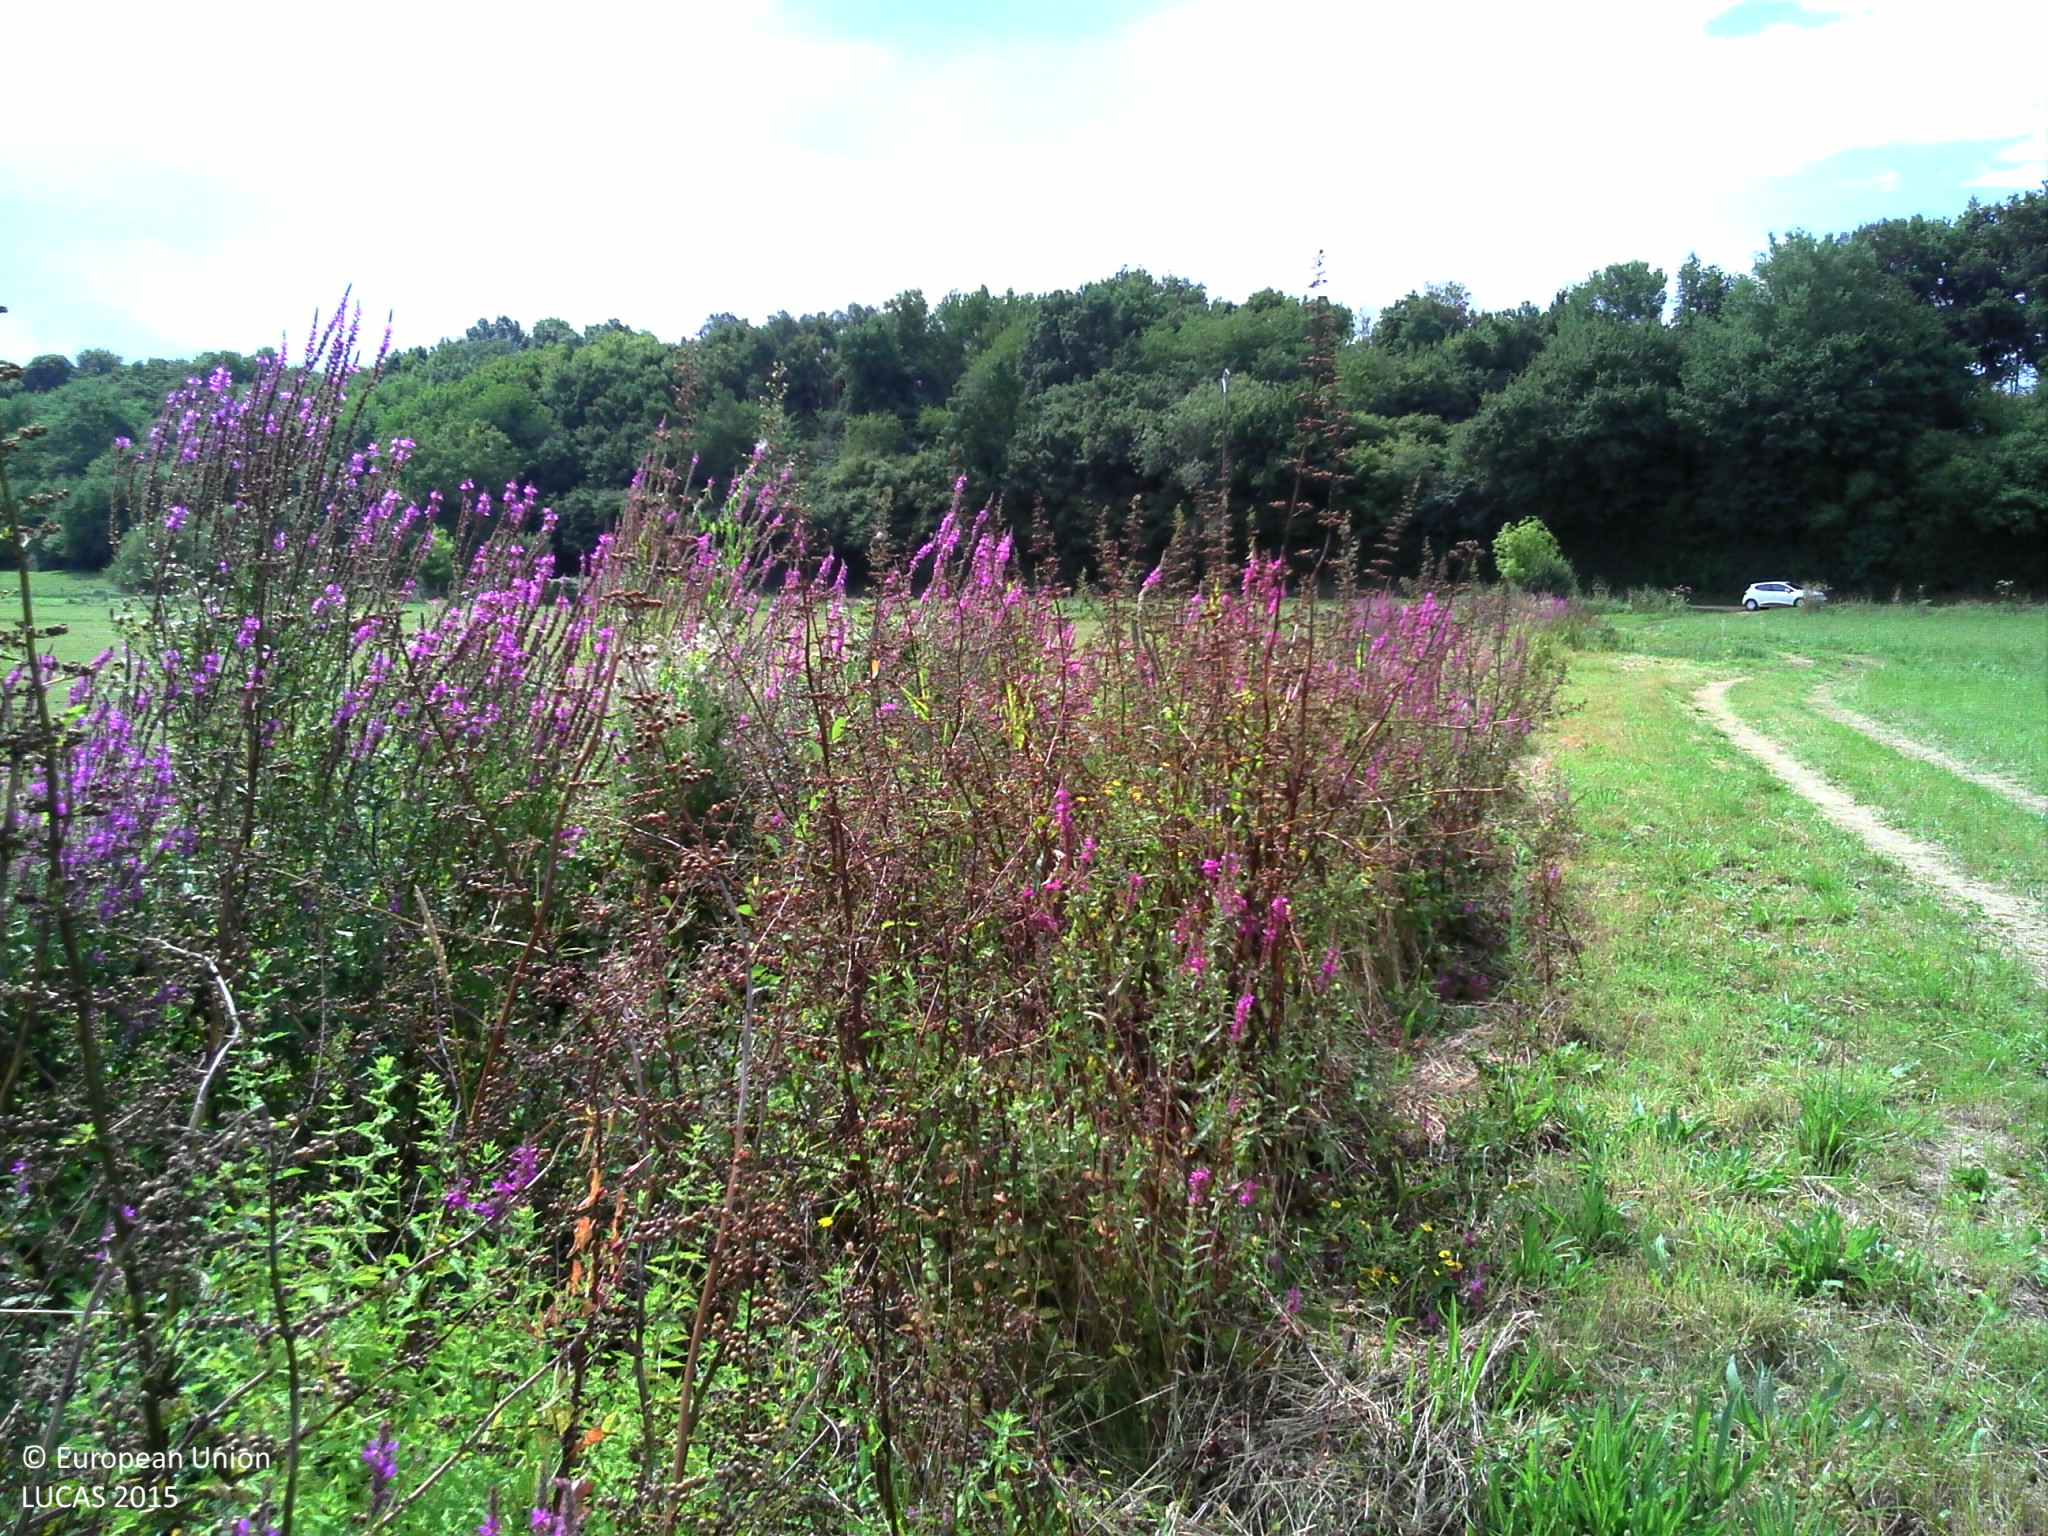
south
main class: Grassland
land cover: Grassland without tree/shrub cover
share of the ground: > 75 %
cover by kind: herbaceous plants 100 %
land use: Agriculture (excluding fallow land and kitchen gardens)
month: August
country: FR
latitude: 46.1415
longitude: 0.2601
